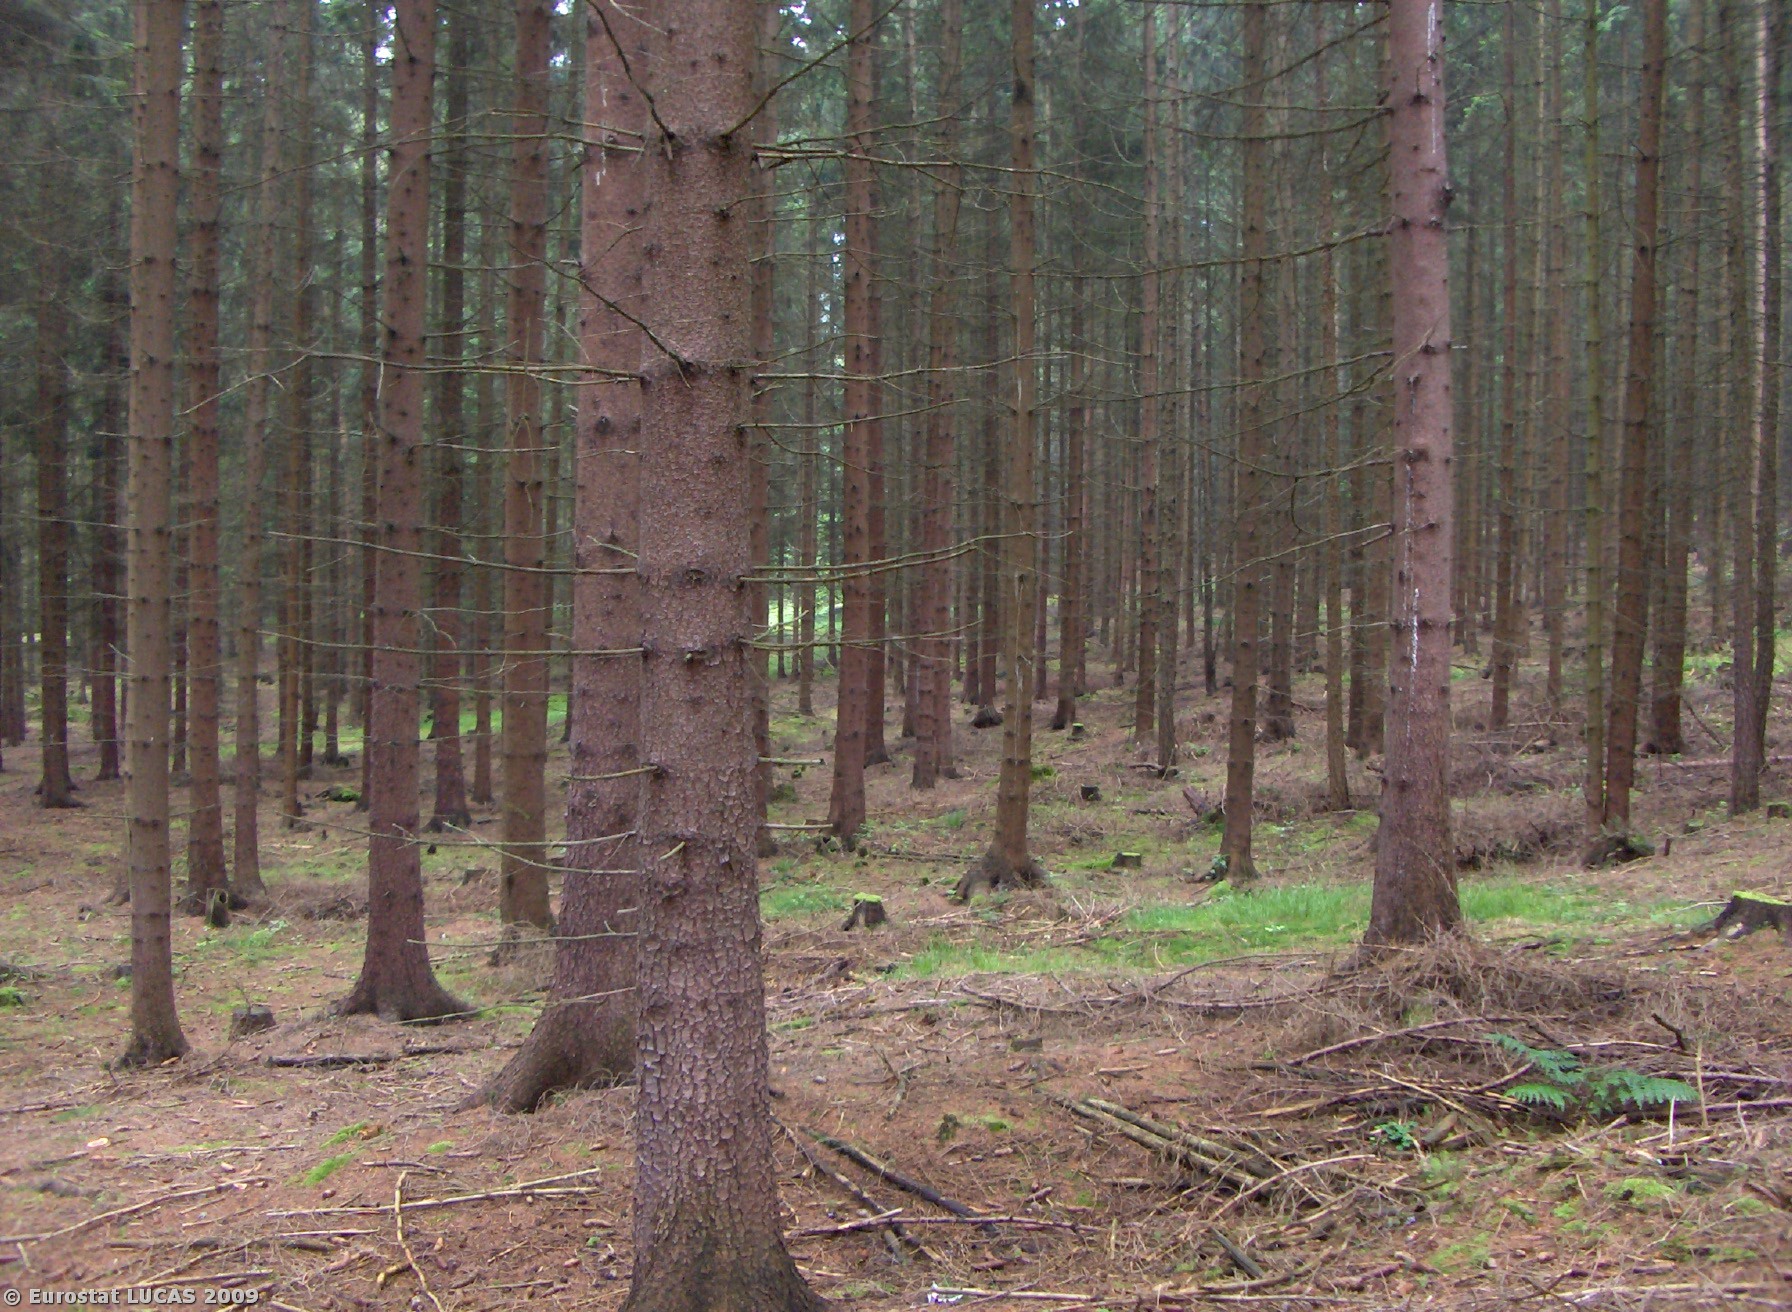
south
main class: Woodland
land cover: Coniferous woodland
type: hemiboreal forest and nemoral coniferous forest and mixed broadleaved-coniferous forest
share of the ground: > 75 %
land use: Forestry
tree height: > 5 m
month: July
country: CZ
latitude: 49.4101
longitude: 12.8803
